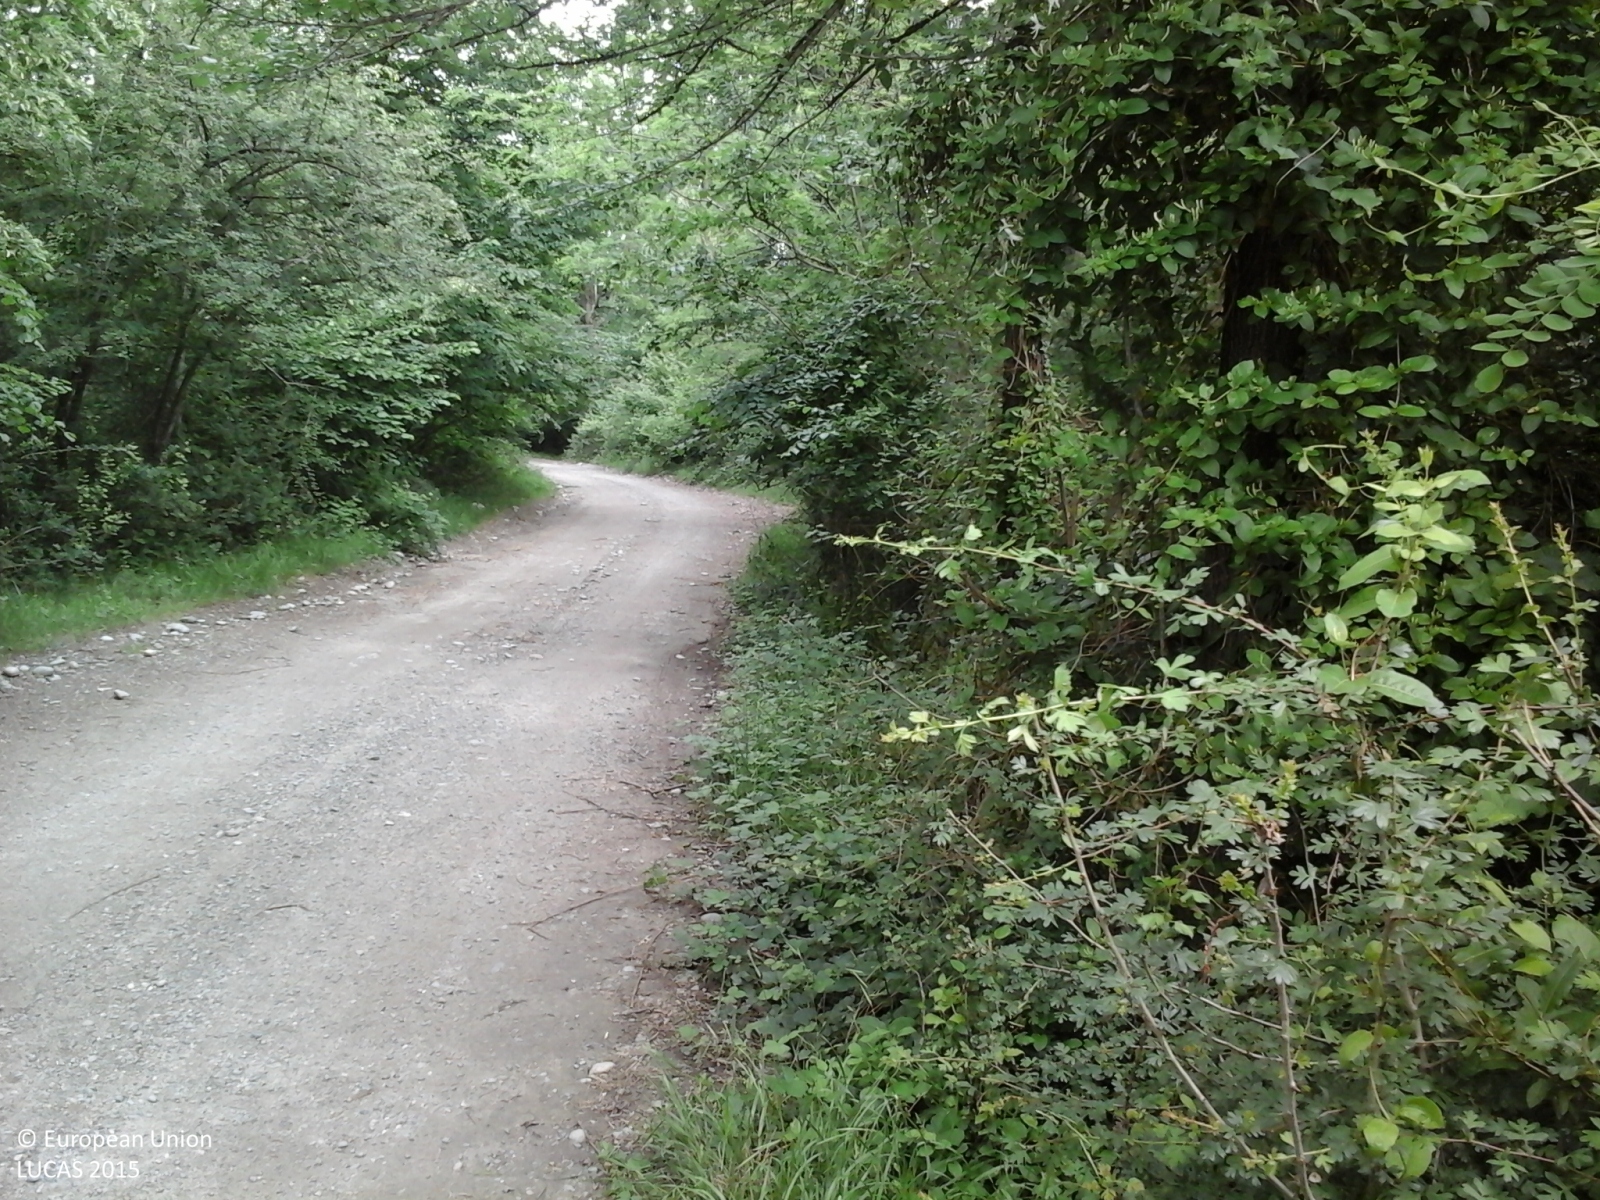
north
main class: Woodland
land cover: Broadleaved woodland
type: thermophilous deciduous forest
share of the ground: > 75 %
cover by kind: broadleaved forest trees 100 %
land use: Forestry
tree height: > 5 m
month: May
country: IT
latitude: 45.5284
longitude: 8.4021
